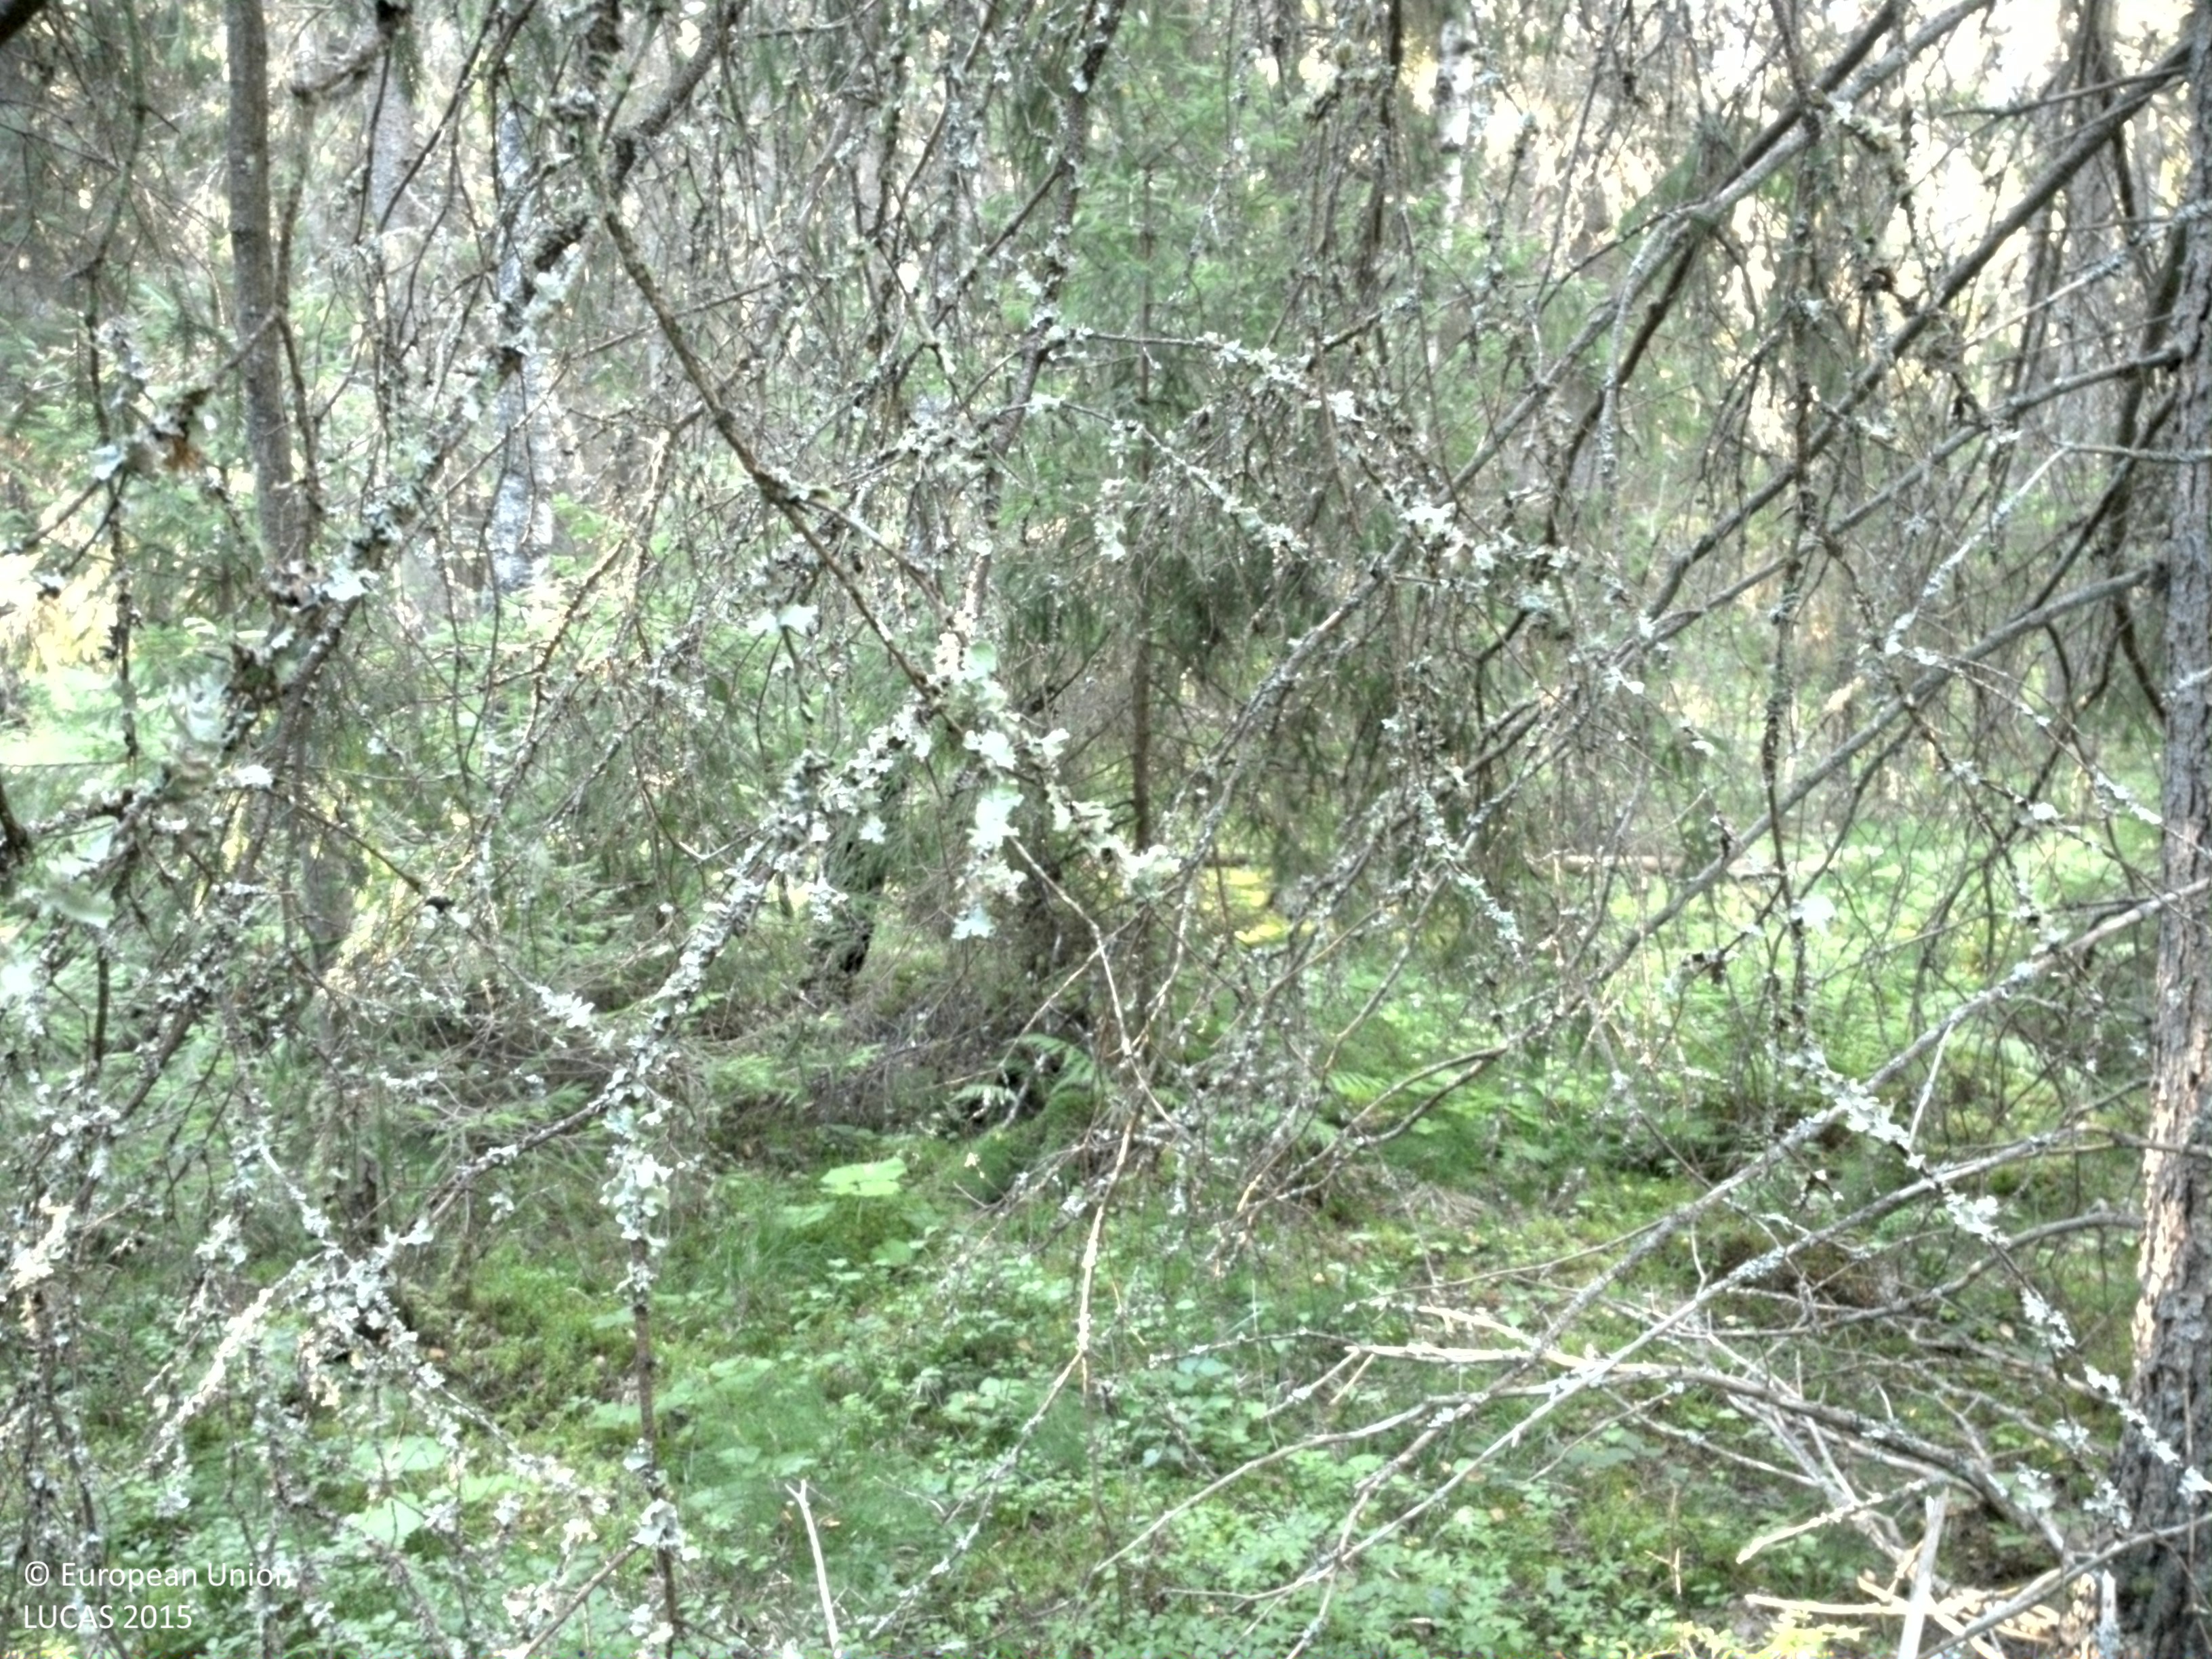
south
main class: Woodland
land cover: Spruce dominated coniferous woodland
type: boreal forest
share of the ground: > 75 %
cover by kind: coniferous forest trees 70 %, herbaceous plants 25 %, broadleaved forest trees 5 %
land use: Forestry
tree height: > 5 m
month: August
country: SE
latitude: 59.7311
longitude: 17.7680
